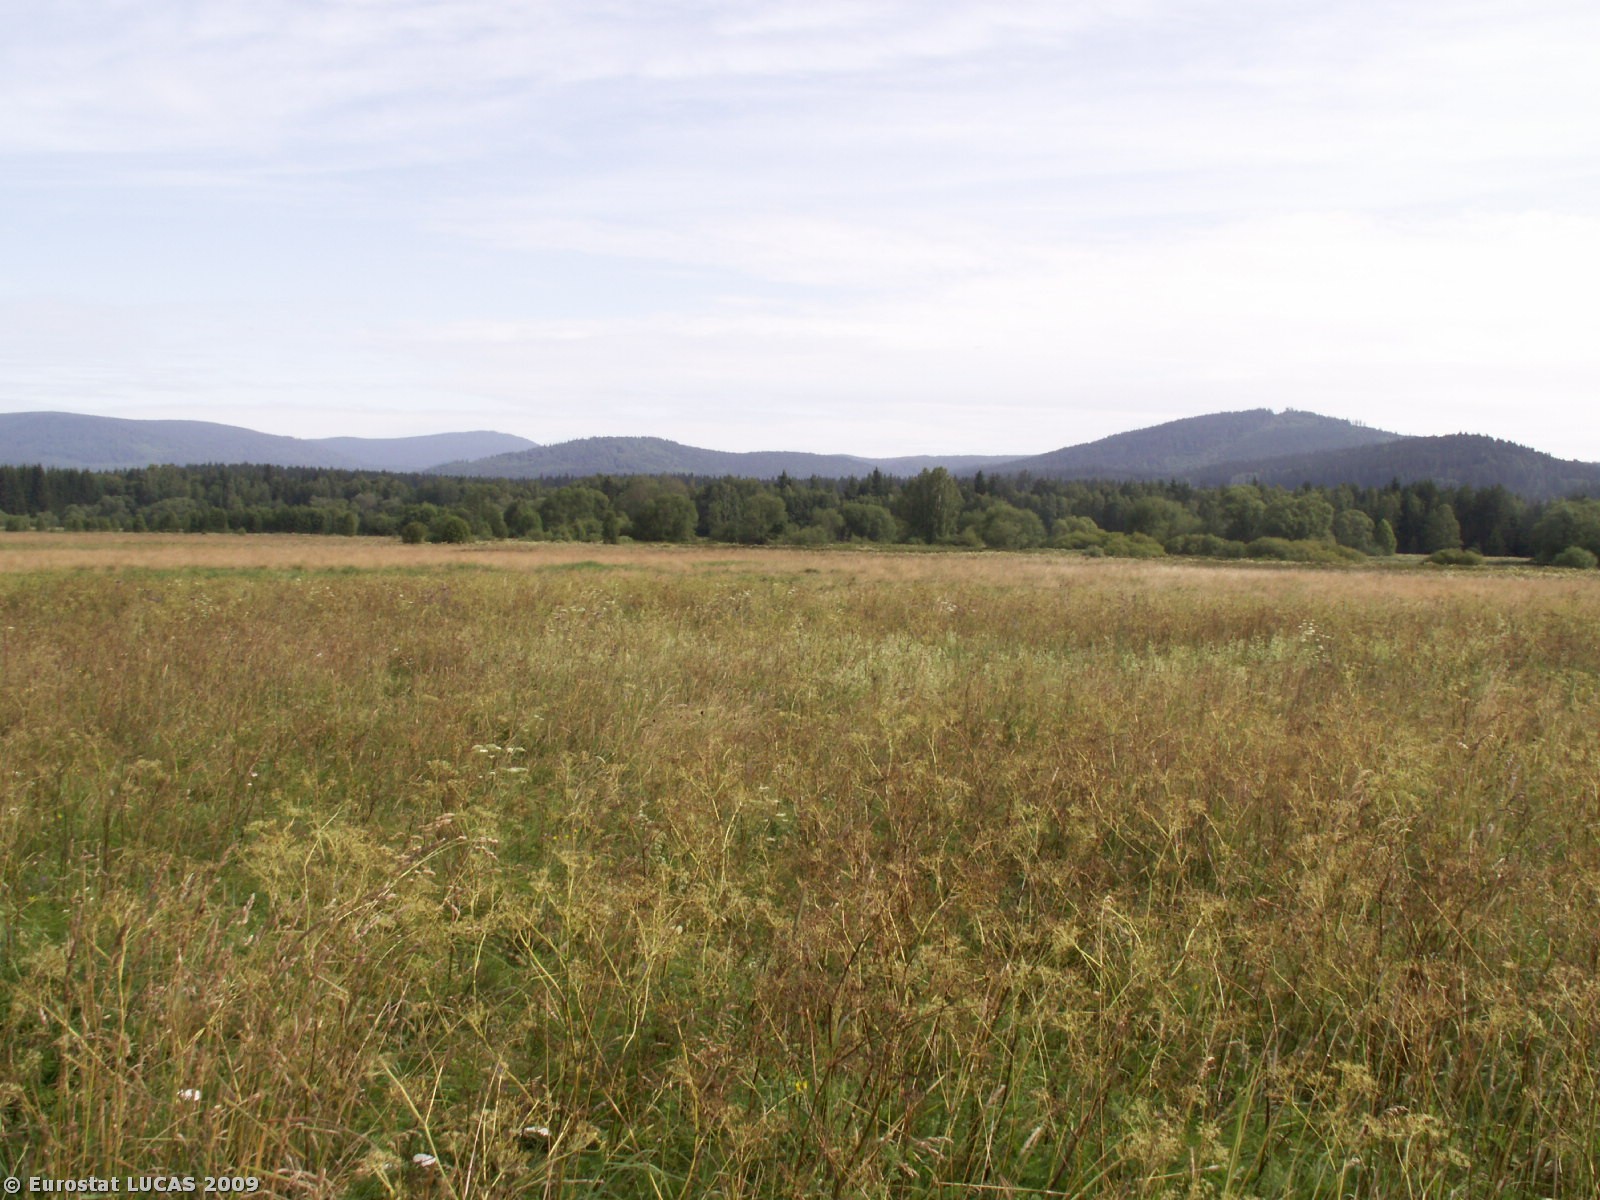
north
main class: Grassland
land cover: Grassland without tree/shrub cover
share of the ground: > 75 %
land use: Fallow land
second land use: Nature reserves
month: July
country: CZ
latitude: 48.8954
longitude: 13.8331
